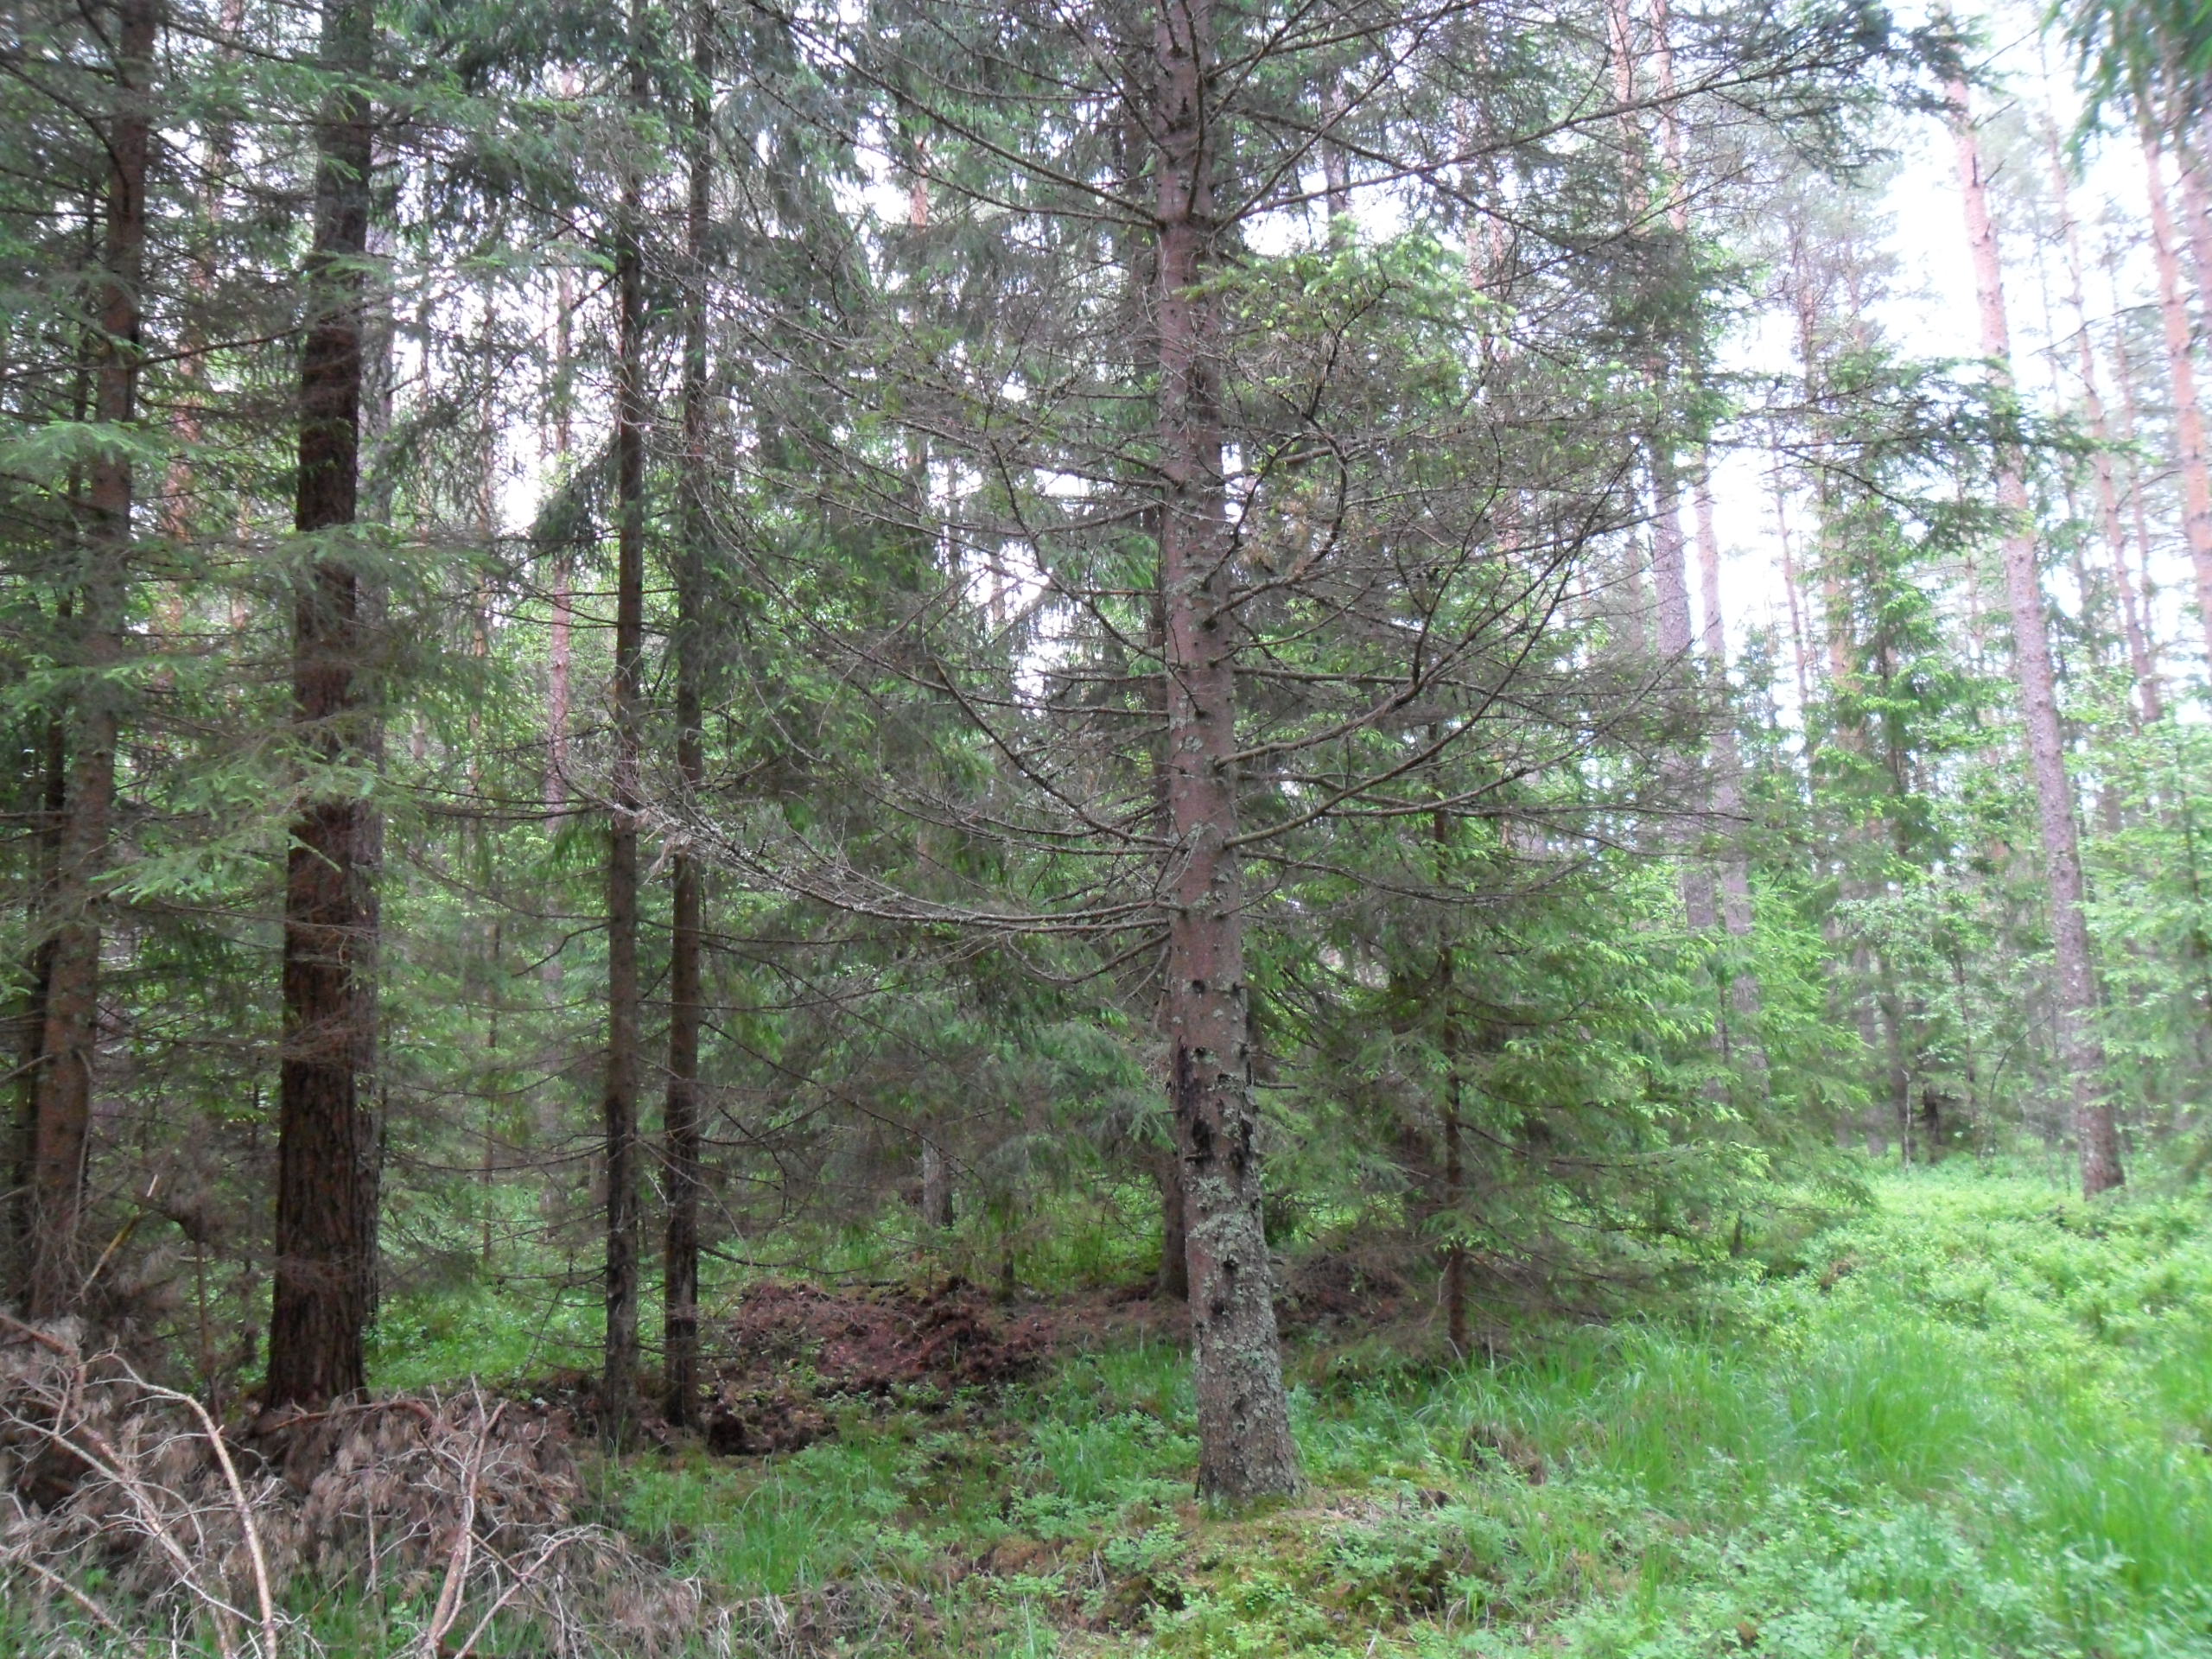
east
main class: Woodland
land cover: Other coniferous woodland
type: hemiboreal forest and nemoral coniferous forest and mixed broadleaved-coniferous forest
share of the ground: > 75 %
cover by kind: coniferous forest trees 70 %, broadleaved forest trees 15 %, herbaceous plants 15 %
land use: Forestry
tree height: > 5 m
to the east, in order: Other coniferous woodland; Tracks; Other coniferous woodland
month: June
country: LV
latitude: 57.2223
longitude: 22.0207
